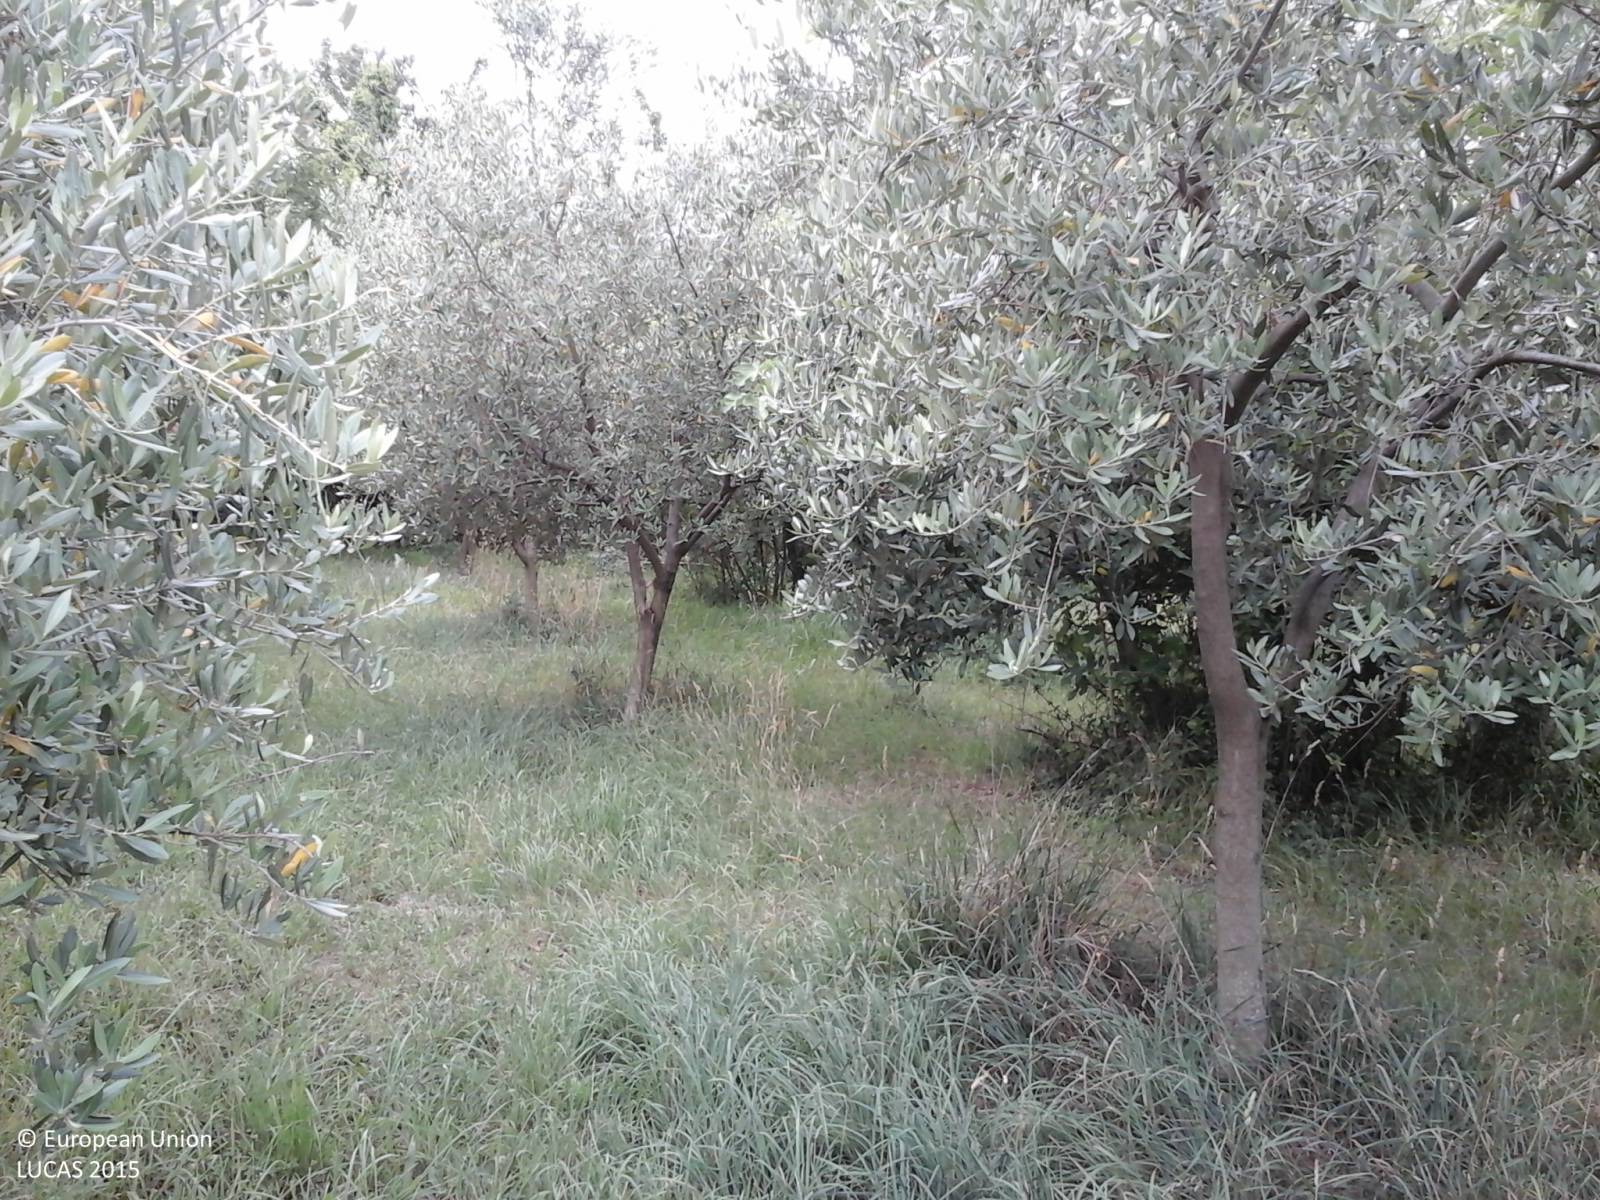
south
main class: Cropland
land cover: Olive groves
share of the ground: 50 - 75 %
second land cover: Grassland without tree/shrub cover
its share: 25 - 50 %
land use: Agriculture (excluding fallow land and kitchen gardens)
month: June
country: IT
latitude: 45.6010
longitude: 13.7263
